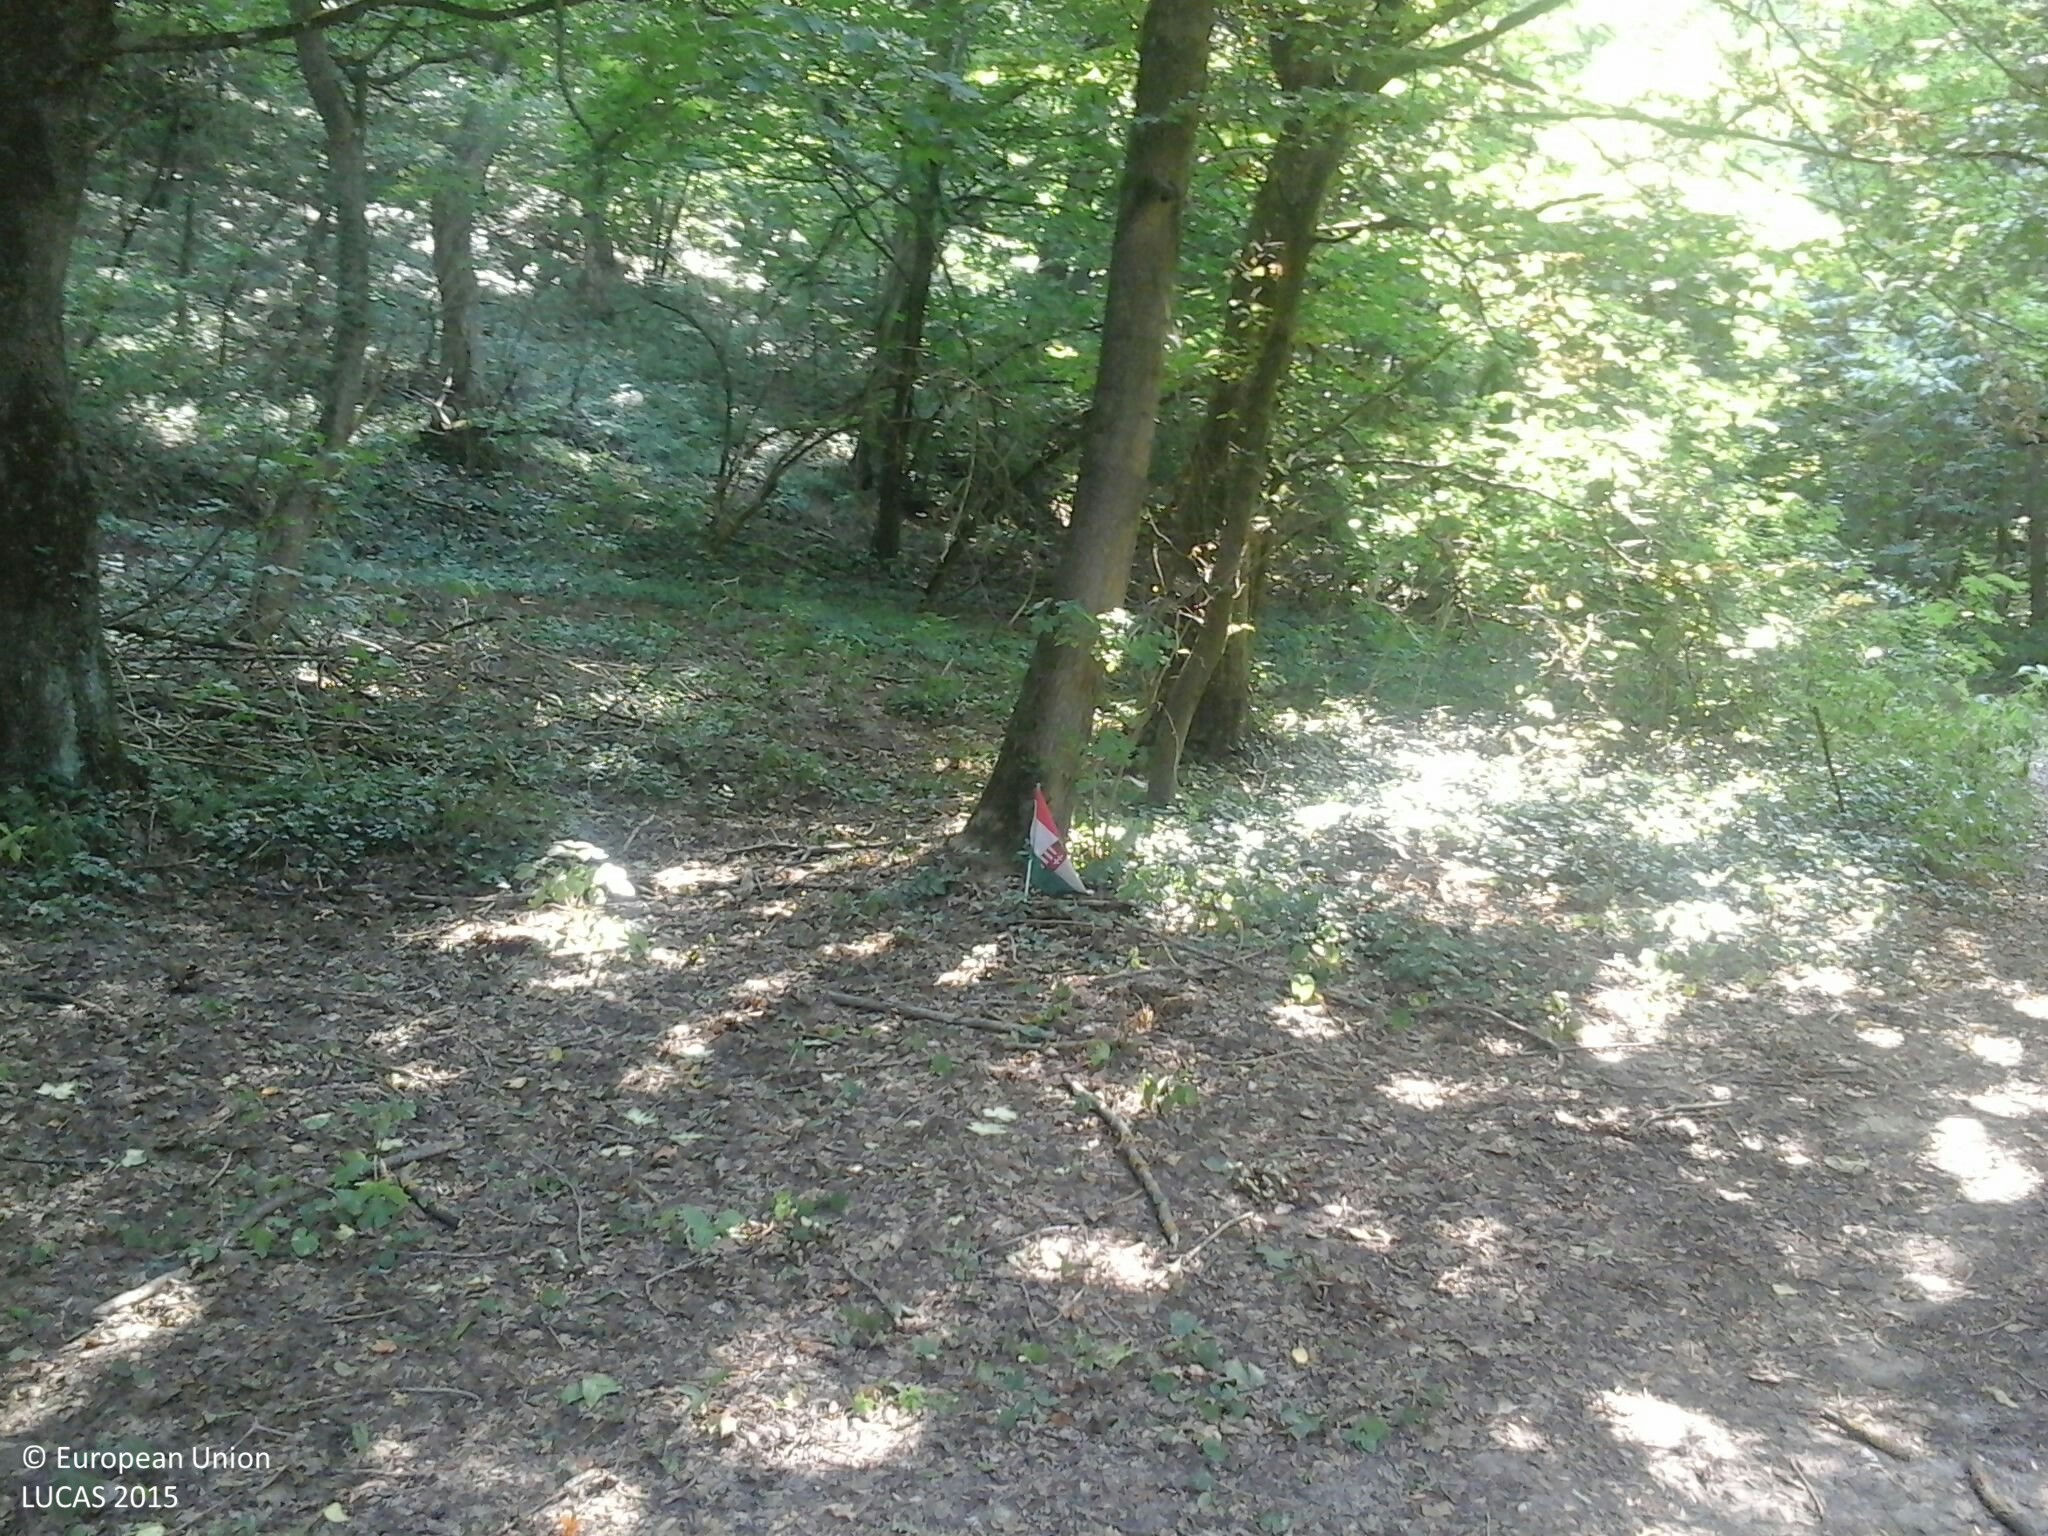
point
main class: Woodland
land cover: Broadleaved woodland
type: mesophytic deciduous forest
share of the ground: > 75 %
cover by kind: broadleaved forest trees 100 %
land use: Forestry
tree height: > 5 m
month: August
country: HU
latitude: 47.7072
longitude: 18.5848
